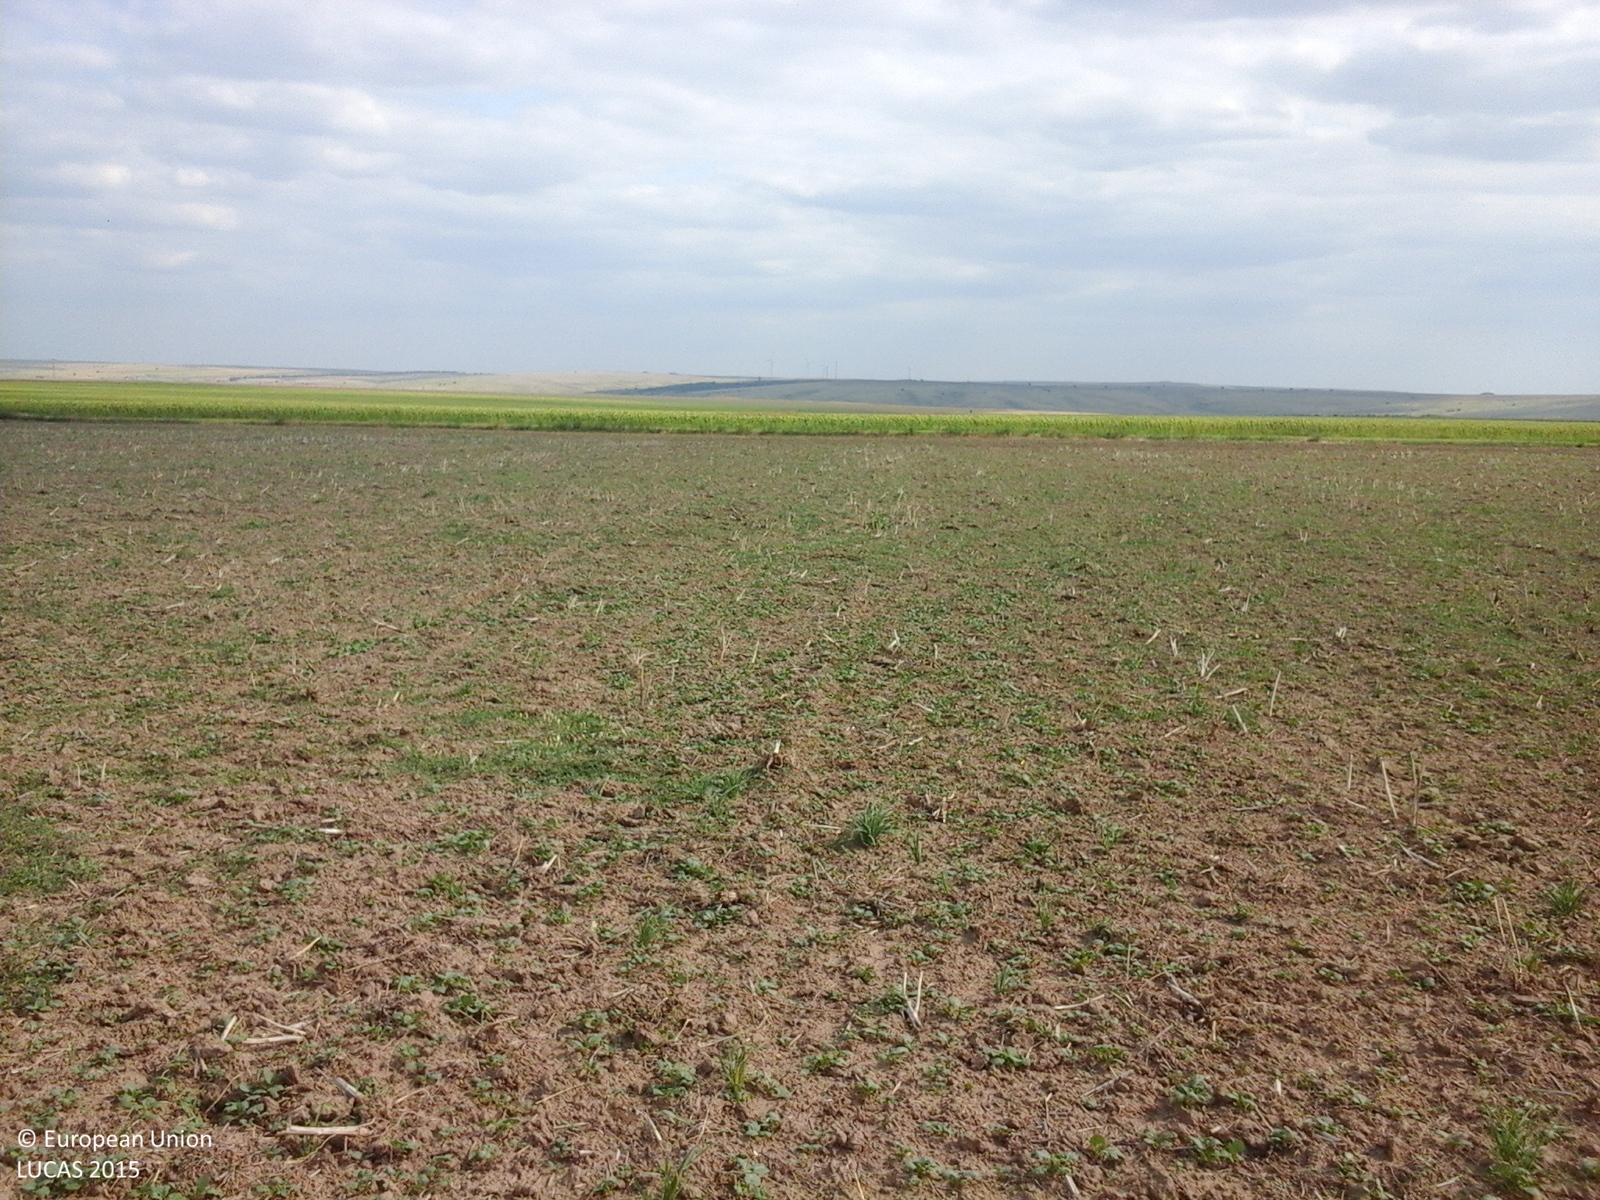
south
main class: Cropland
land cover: Rape and turnip rape
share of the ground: 10 - 25 %
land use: Agriculture (excluding fallow land and kitchen gardens)
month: August
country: RO
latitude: 44.7510
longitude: 28.1133
